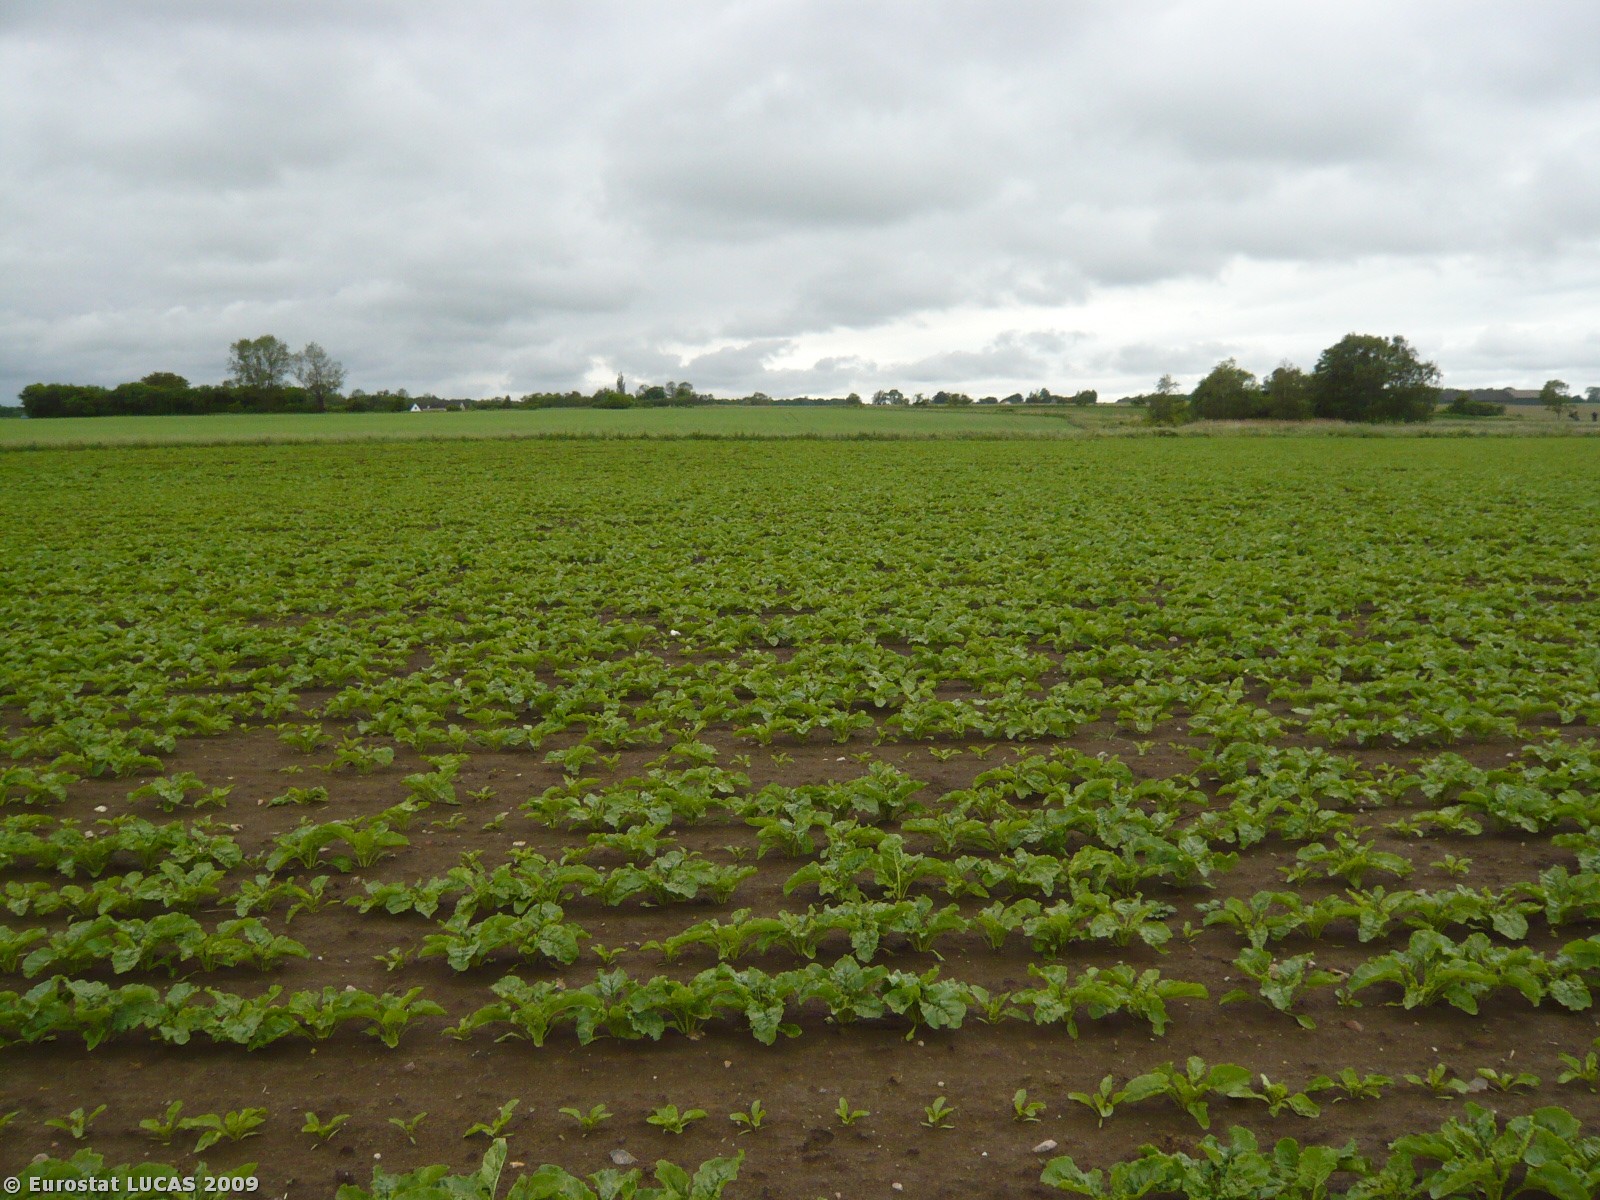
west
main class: Cropland
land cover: Sugar beet
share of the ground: 25 - 50 %
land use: Agriculture (excluding fallow land and kitchen gardens)
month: June
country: DK
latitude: 54.8231
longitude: 12.0377
